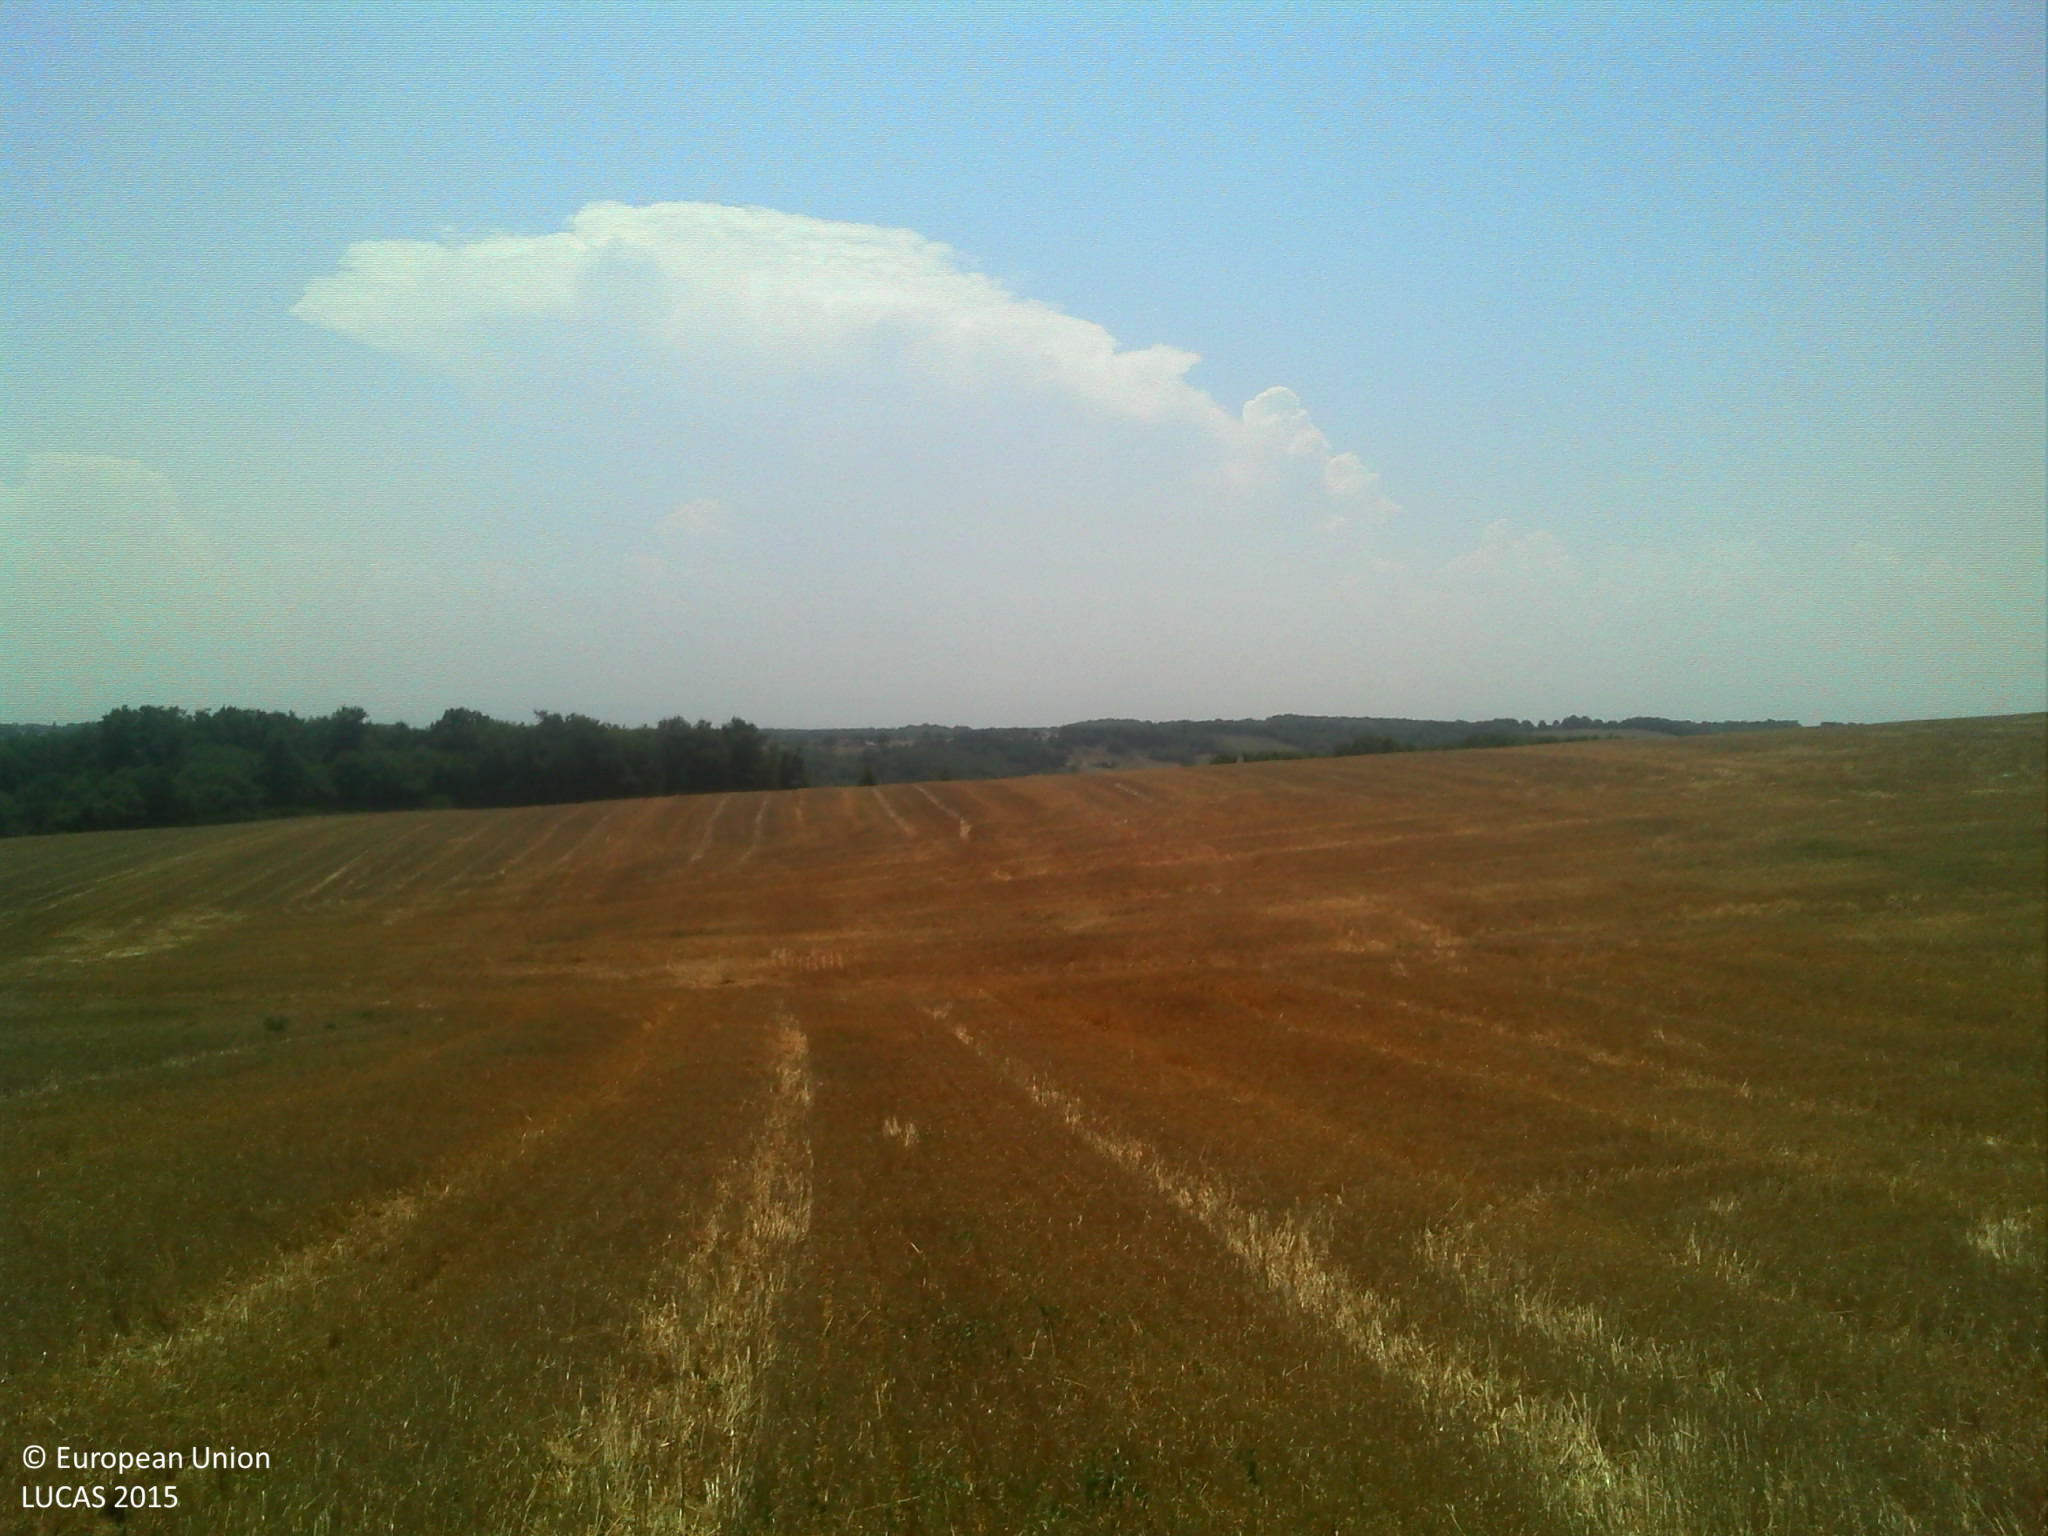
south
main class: Cropland
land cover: Common wheat
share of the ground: > 75 %
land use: Agriculture (excluding fallow land and kitchen gardens)
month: July
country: FR
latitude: 43.3671
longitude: 1.0800
